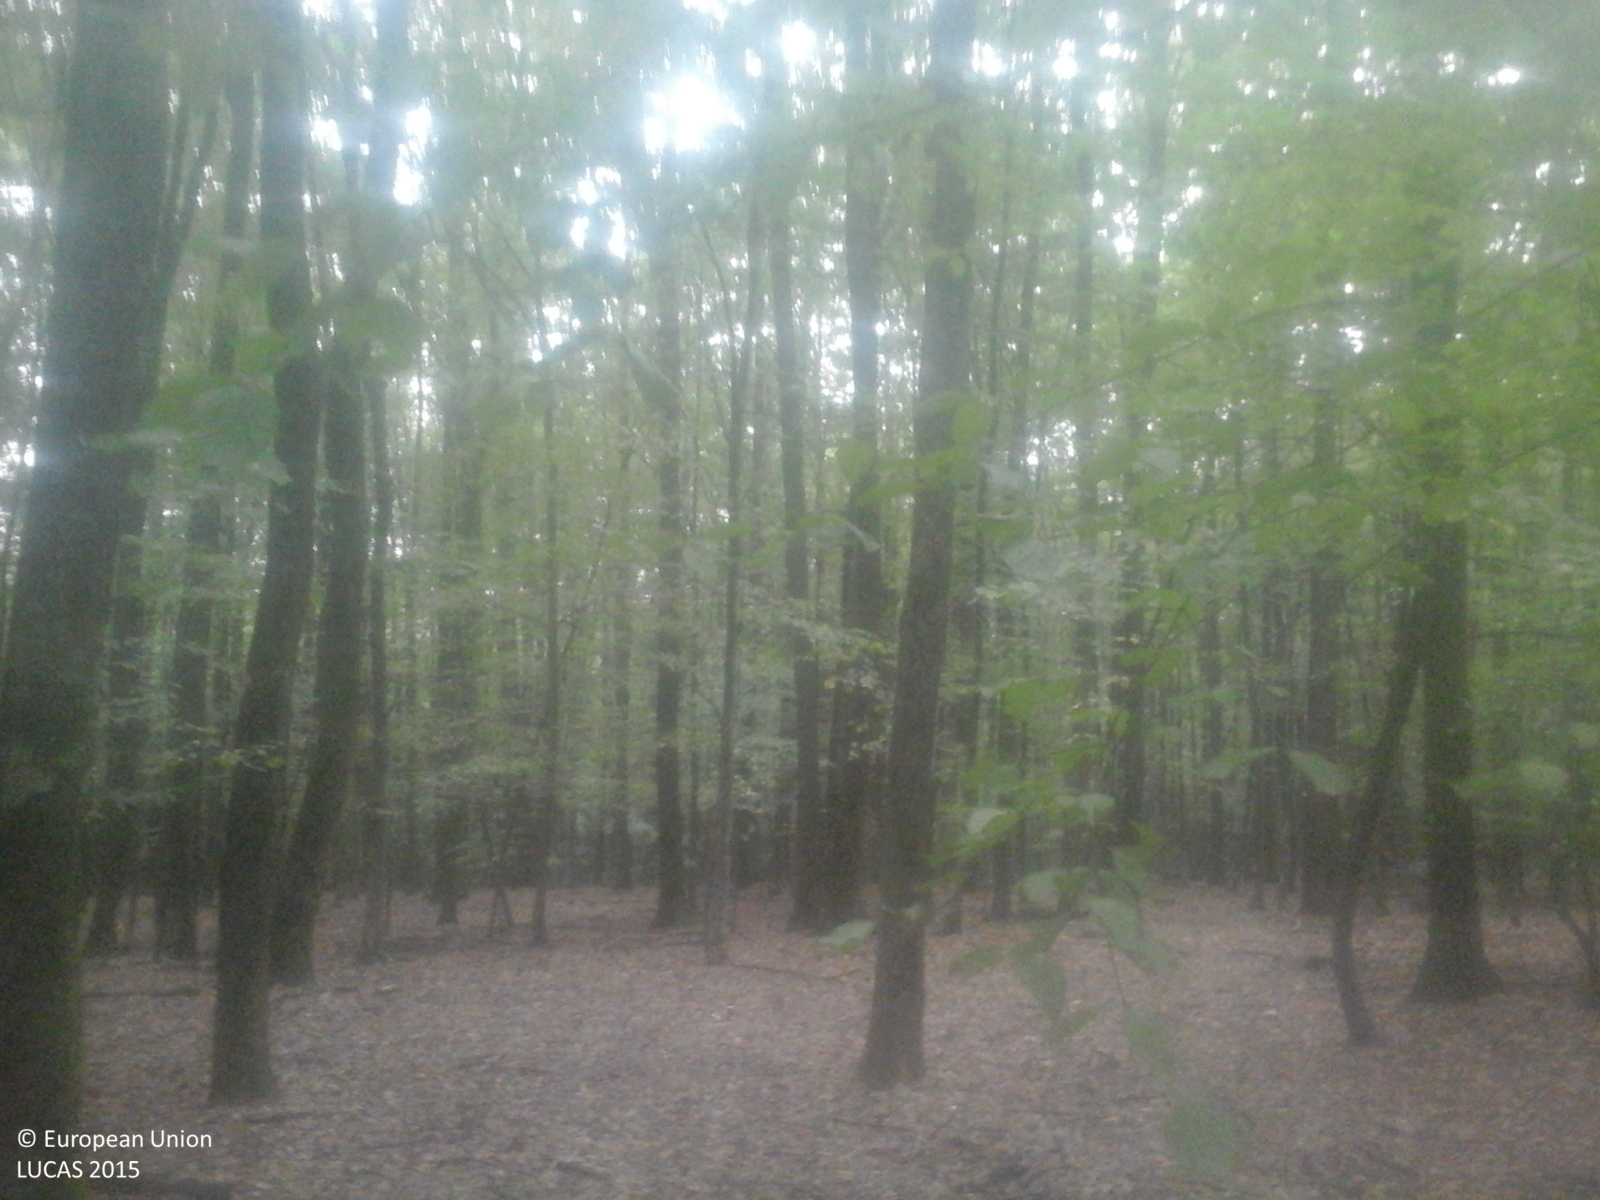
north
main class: Woodland
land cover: Broadleaved woodland
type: beech forest
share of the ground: > 75 %
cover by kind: broadleaved forest trees 100 %
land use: Forestry
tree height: > 5 m
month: September
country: RO
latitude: 45.5113
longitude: 21.9809
